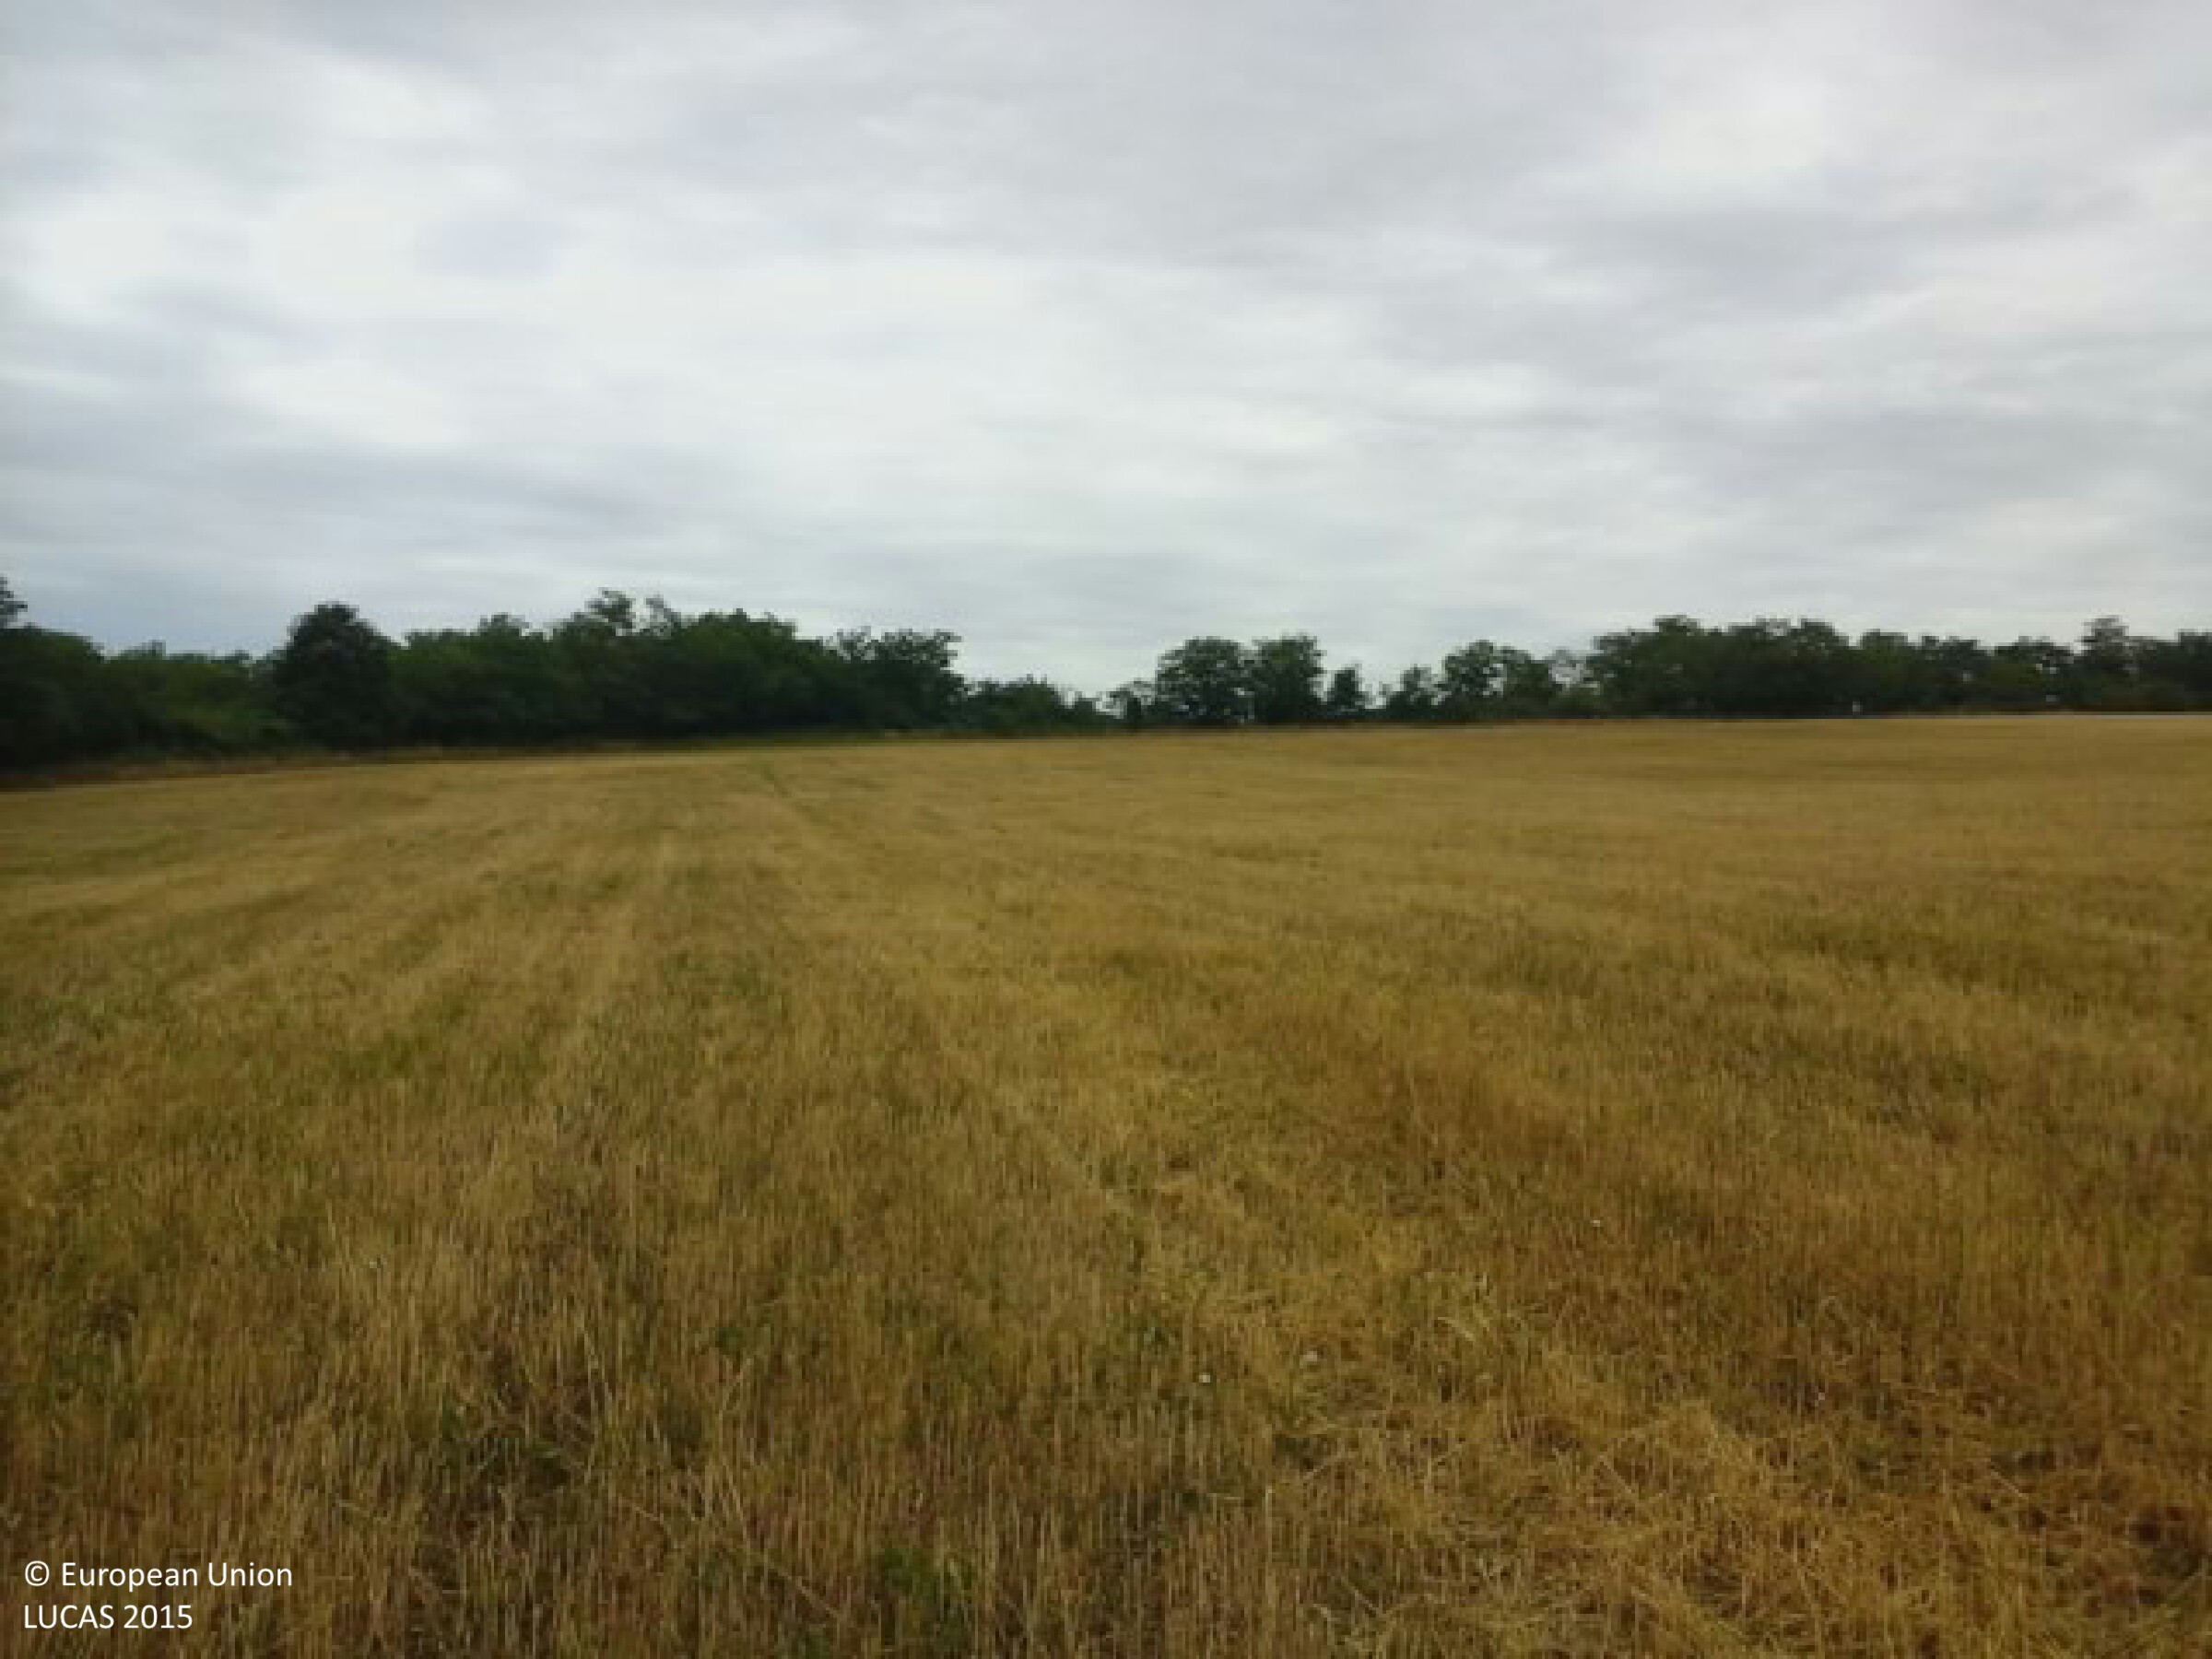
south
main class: Cropland
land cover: Common wheat
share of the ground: 50 - 75 %
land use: Agriculture (excluding fallow land and kitchen gardens)
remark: Harvested field
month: July
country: HU
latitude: 47.7621
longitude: 19.4545
